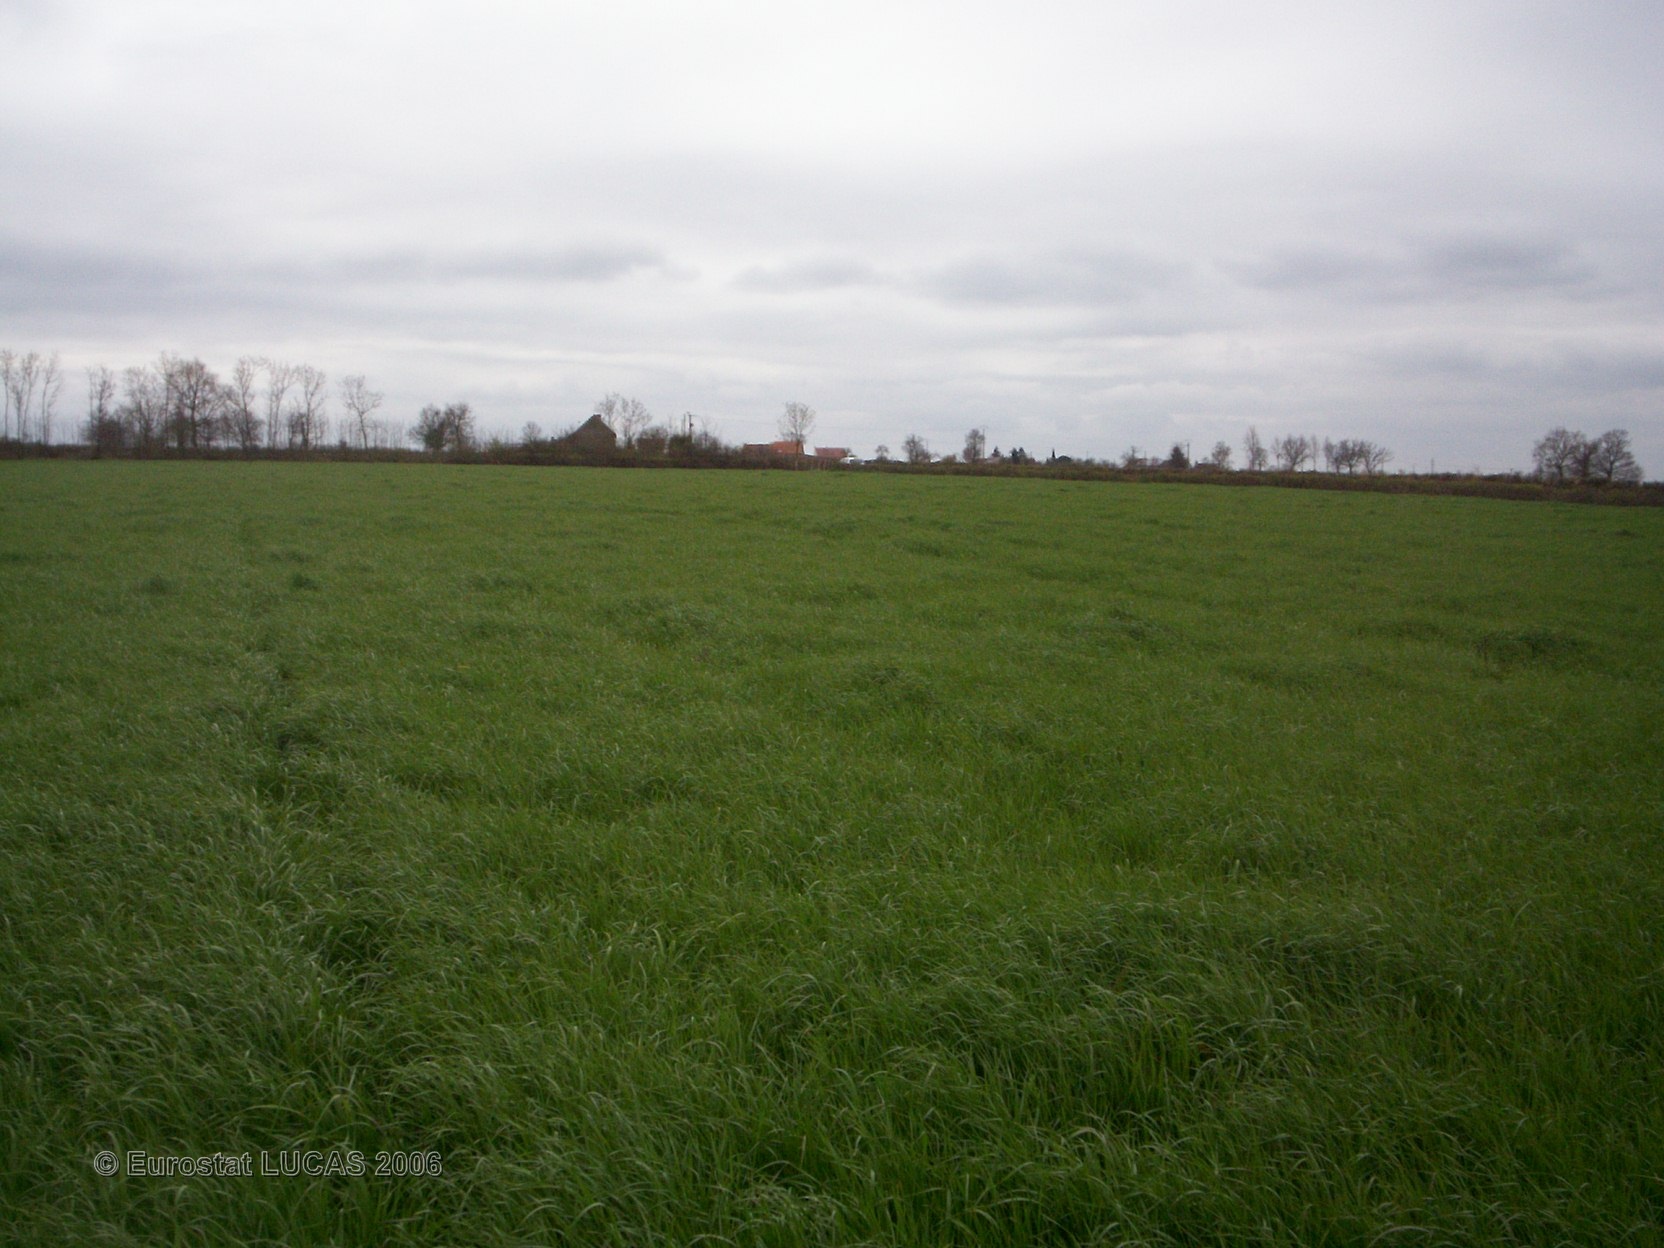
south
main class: Cropland
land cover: Barley
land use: Agriculture (excluding fallow land and kitchen gardens)
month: April
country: FR
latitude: 46.6677
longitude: 3.0564
